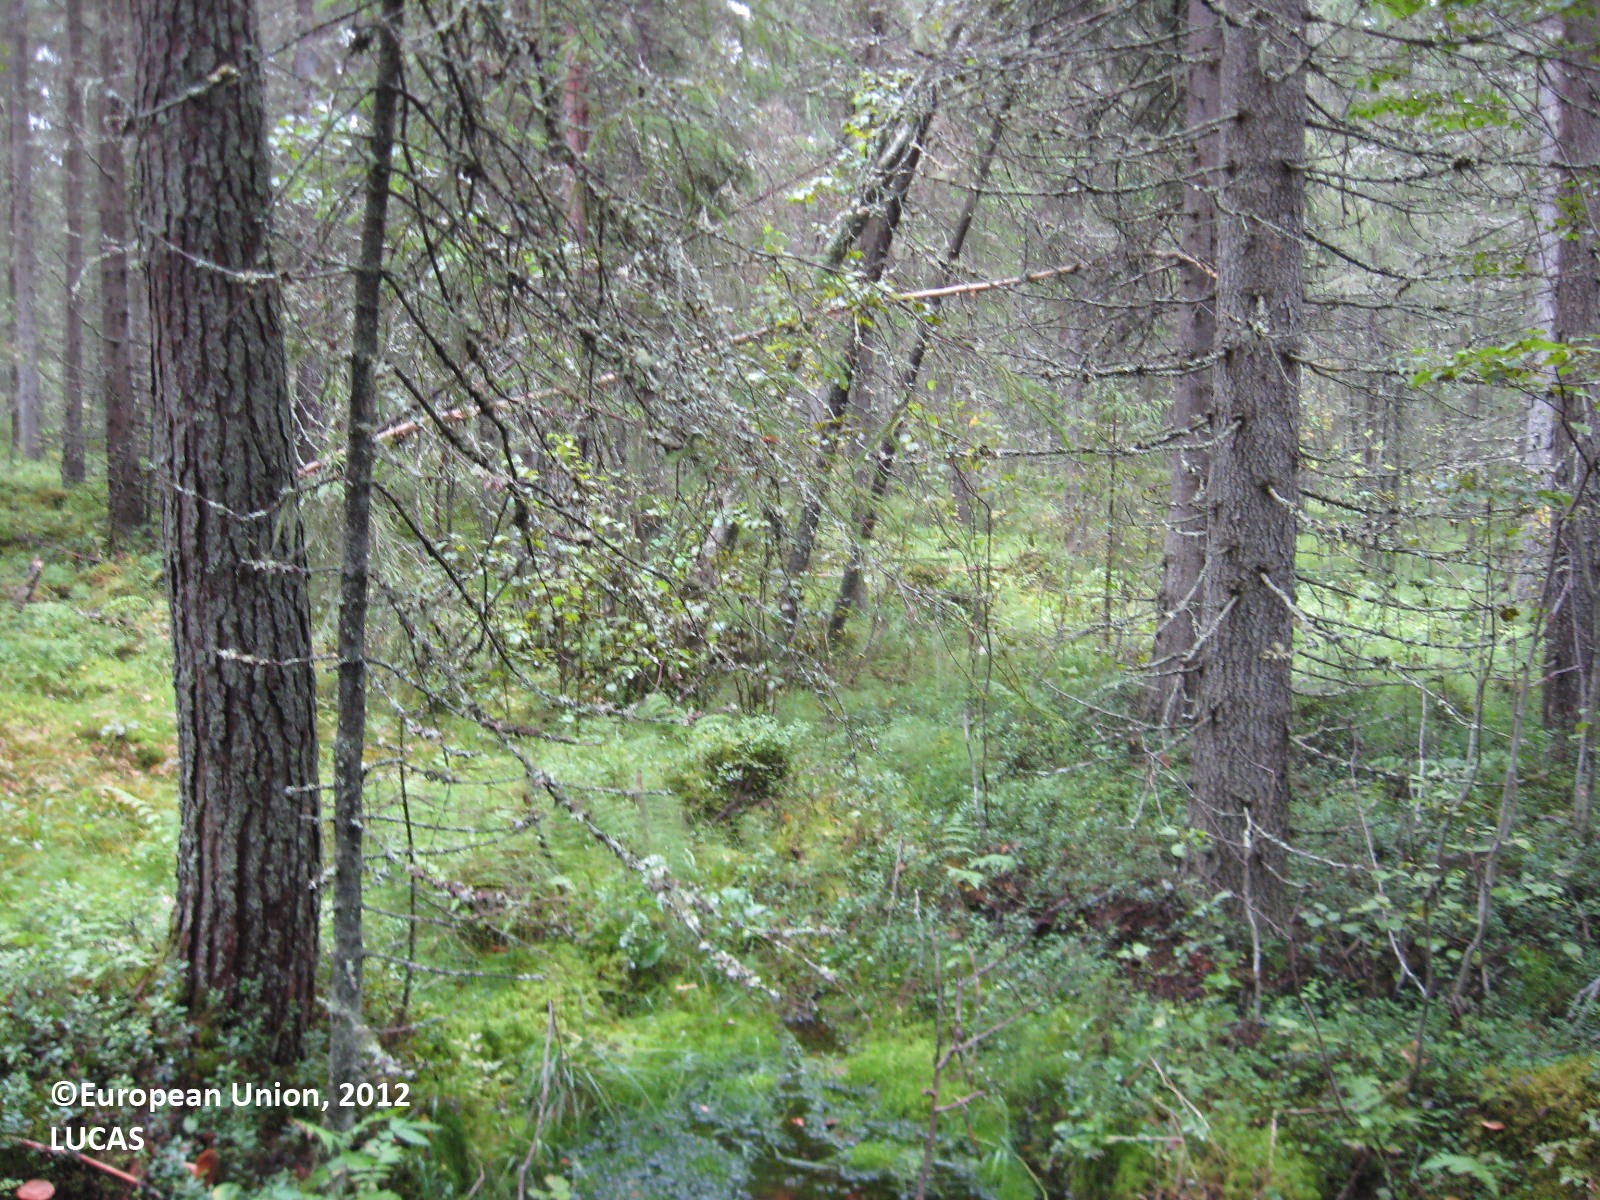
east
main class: Woodland
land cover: Spruce dominated coniferous woodland
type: boreal forest
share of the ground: > 75 %
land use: Forestry
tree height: > 5 m
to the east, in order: Spruce dominated coniferous woodland; Ditches and canals; Other mixed woodland; Ditches and canals; Pine dominated coniferous woodland
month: August
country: FI
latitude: 63.4833
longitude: 29.5214
